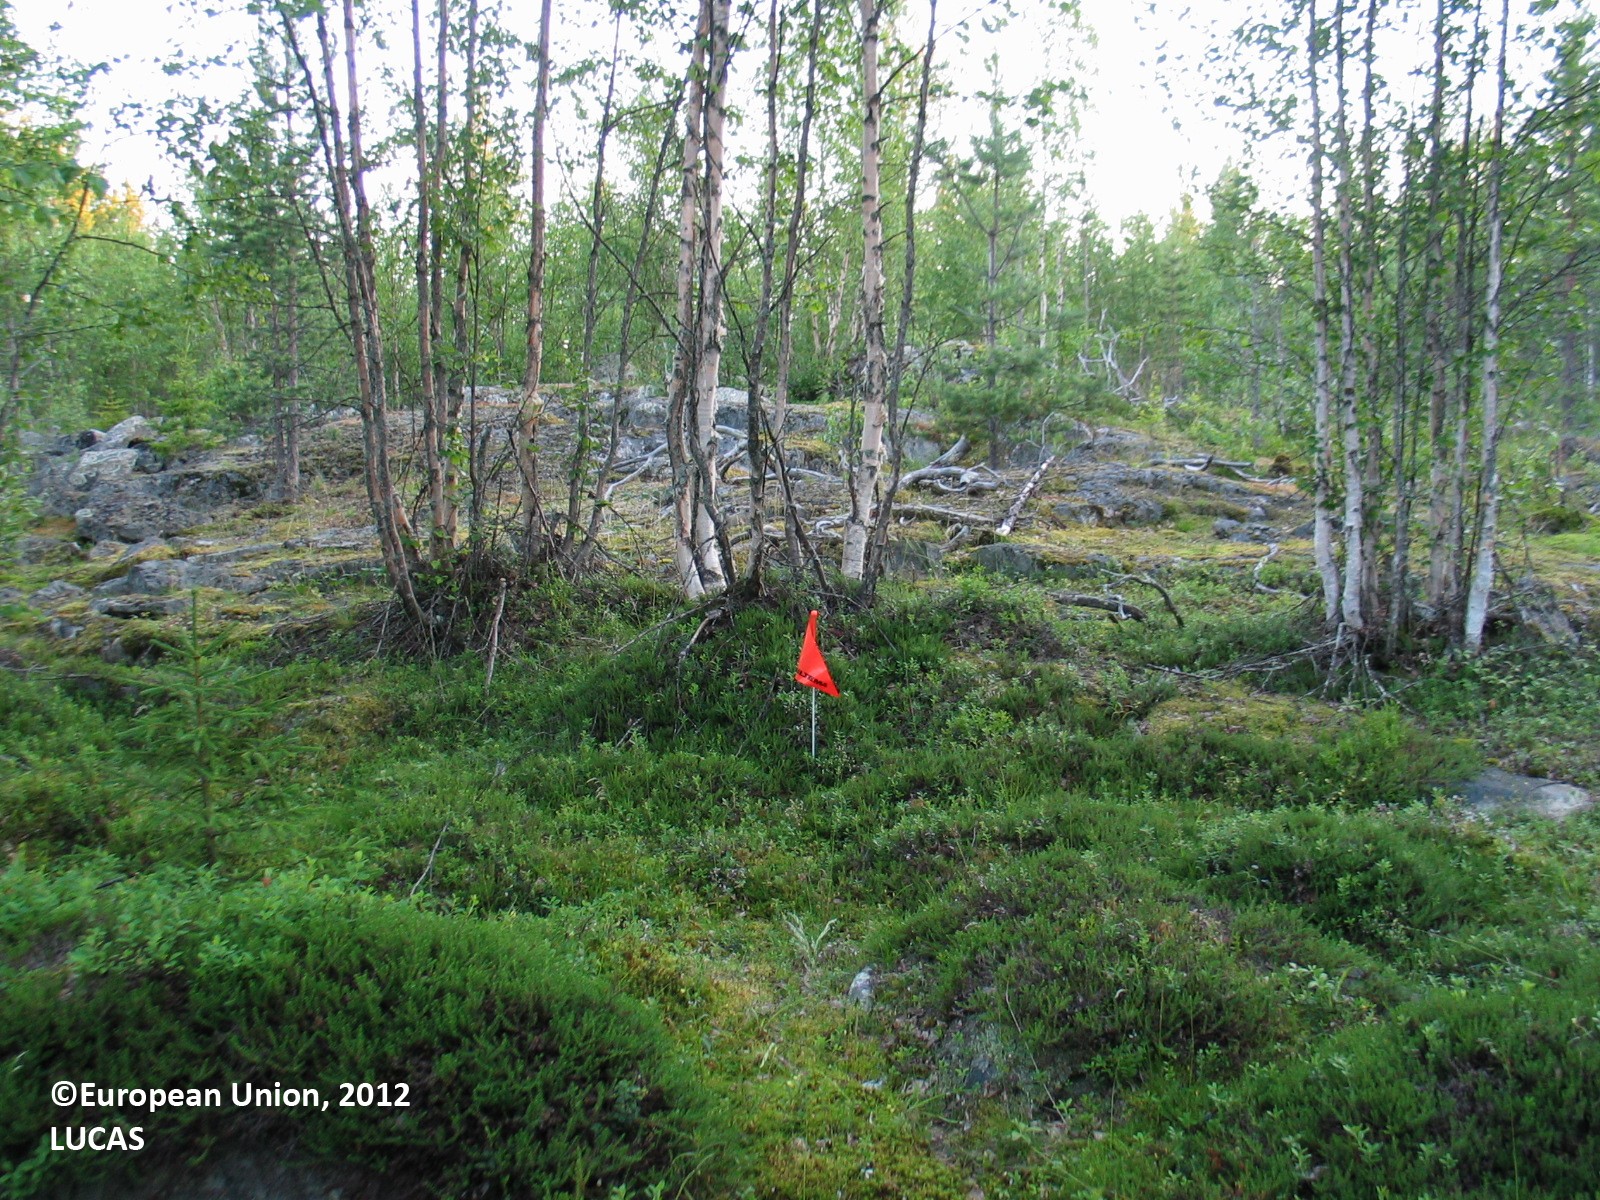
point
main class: Woodland
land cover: Other mixed woodland
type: boreal forest
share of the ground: 25 - 50 %
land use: Forestry
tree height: > 5 m
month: July
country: FI
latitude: 65.6736
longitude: 25.0111
